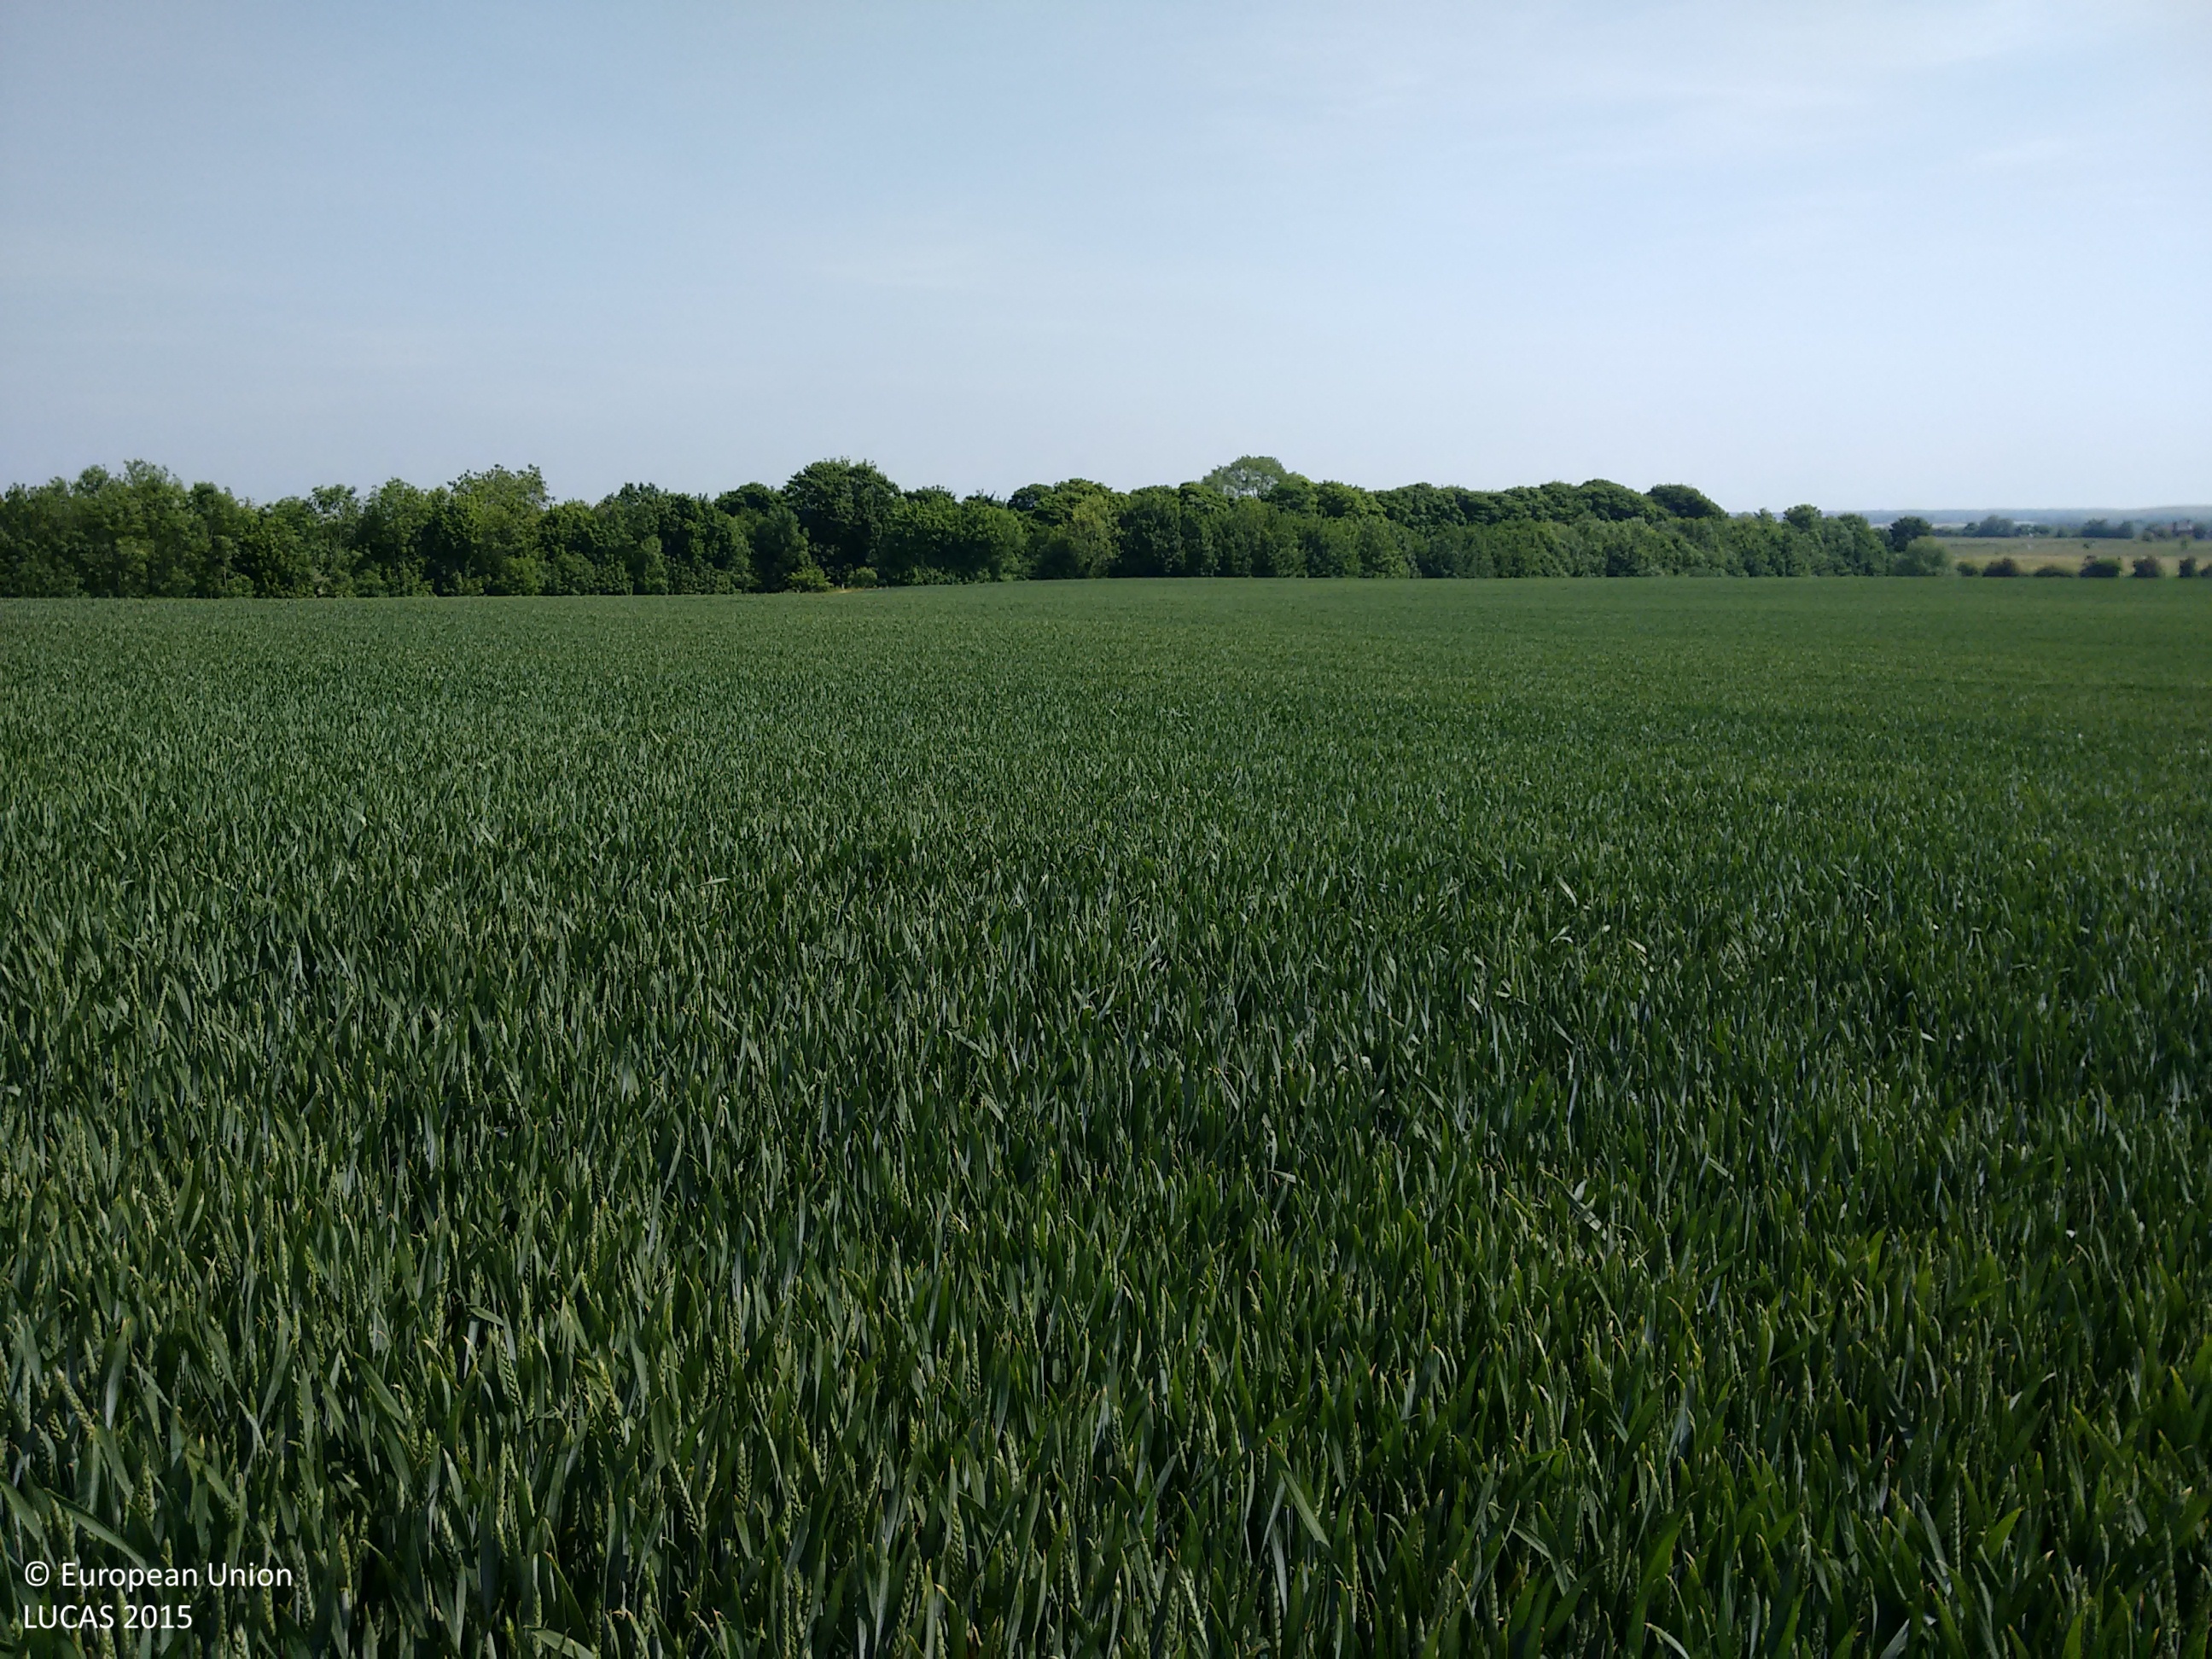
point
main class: Cropland
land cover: Common wheat
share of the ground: > 75 %
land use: Agriculture (excluding fallow land and kitchen gardens)
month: June
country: GB
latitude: 53.7827
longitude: -1.2620
